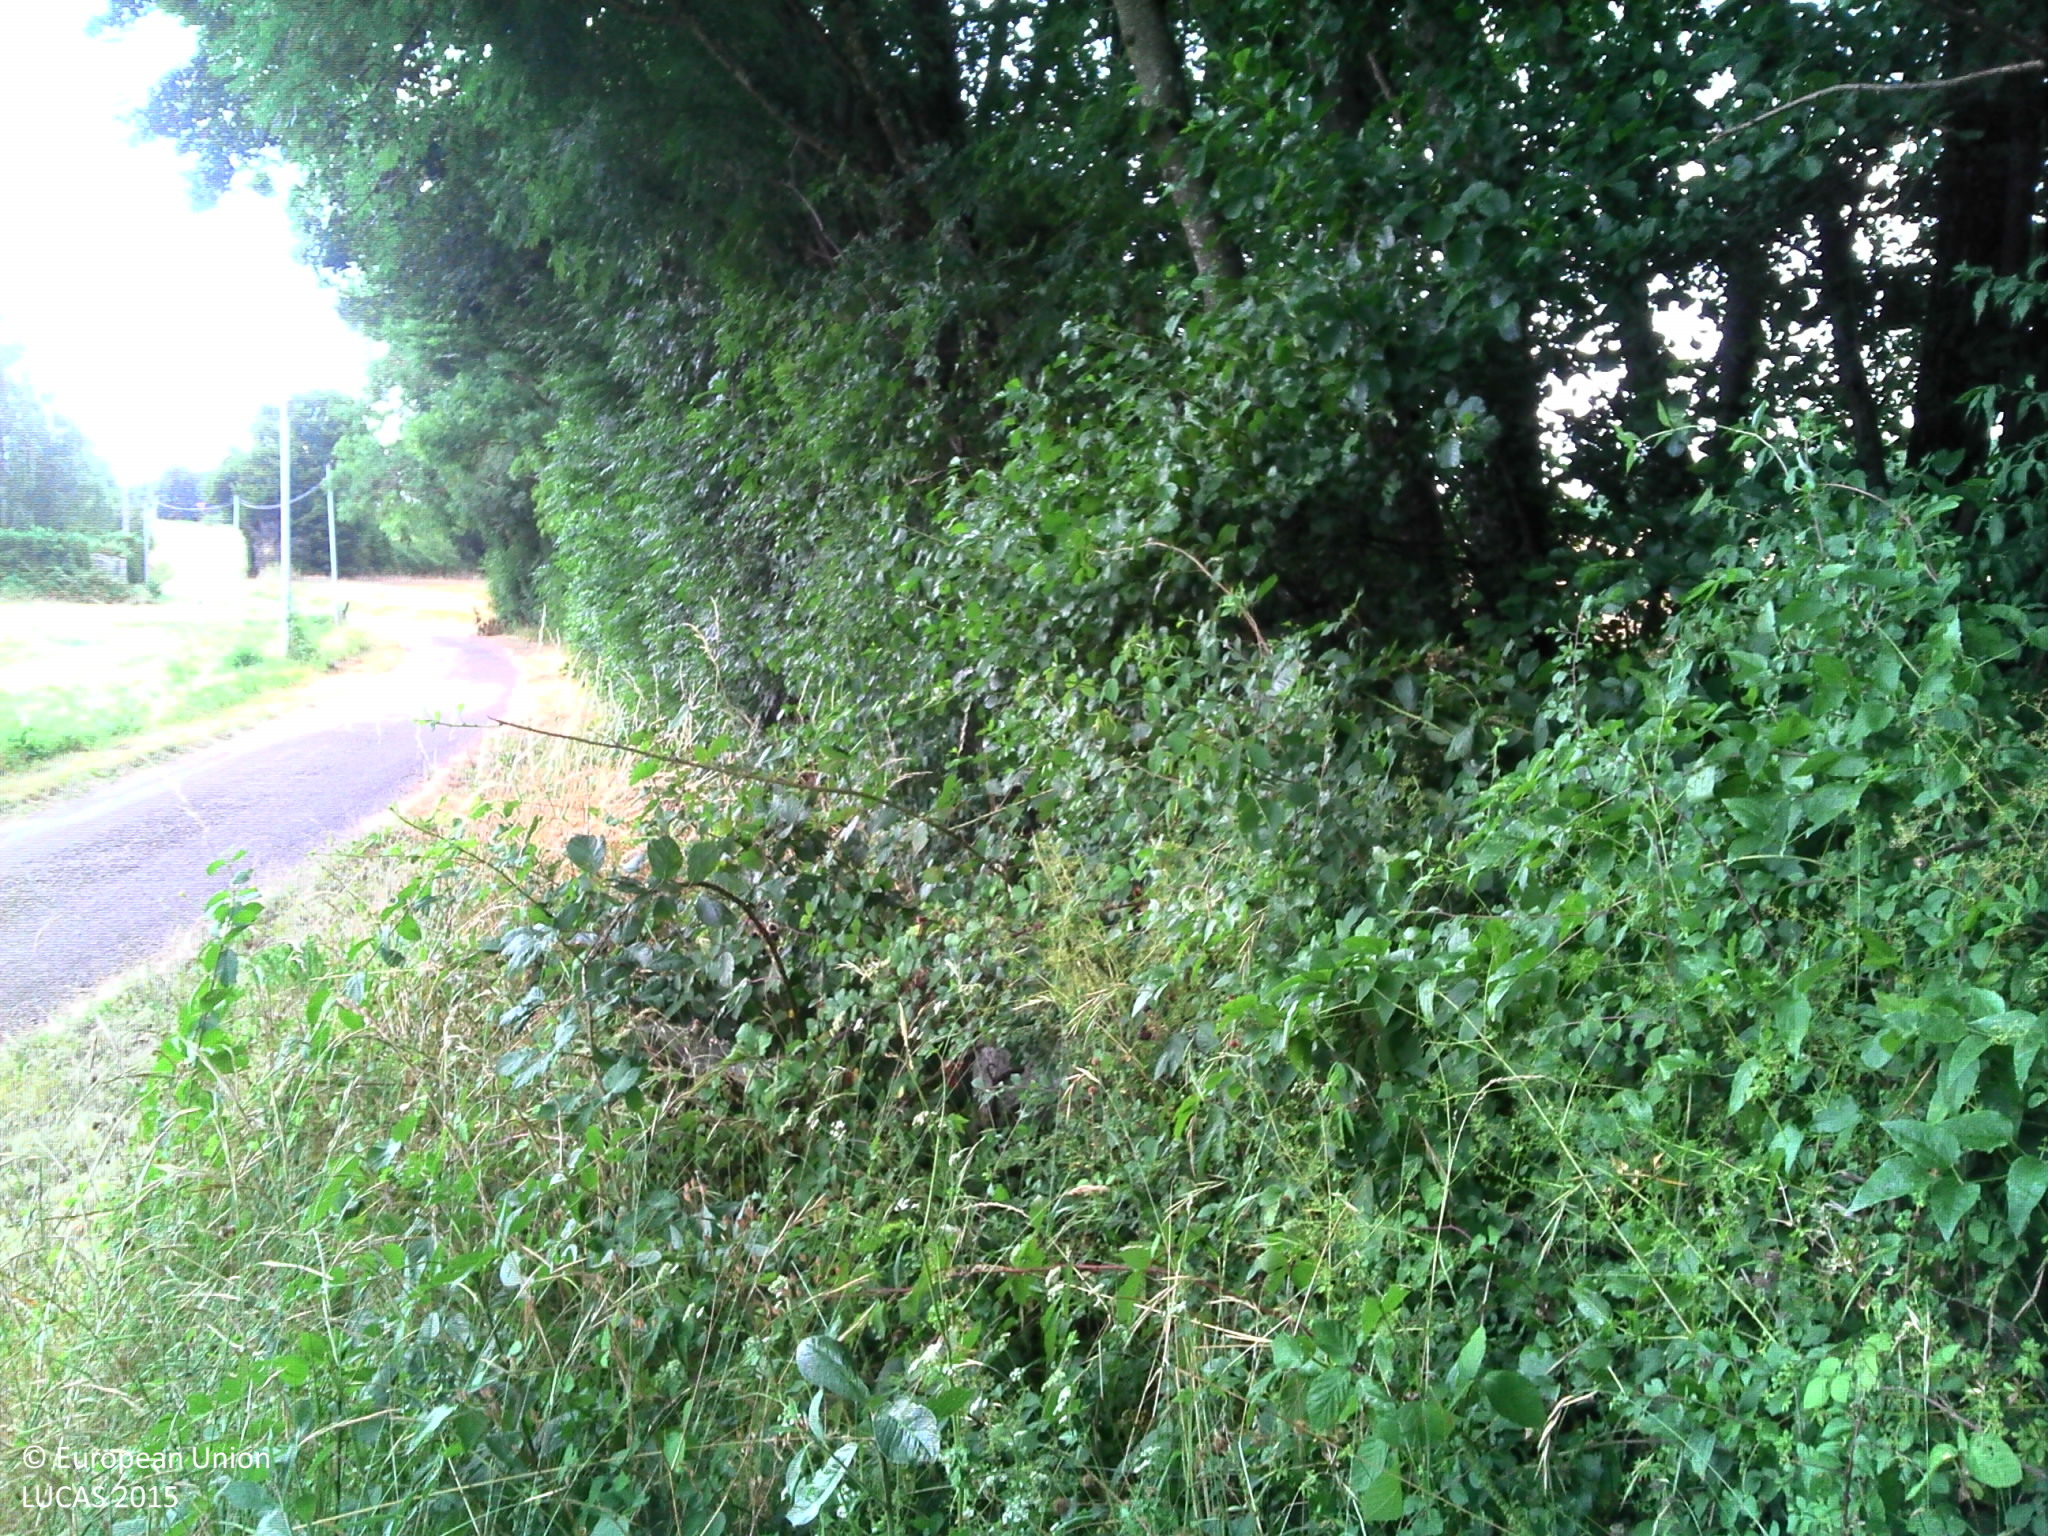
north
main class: Woodland
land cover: Broadleaved woodland
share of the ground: > 75 %
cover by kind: broadleaved forest trees 75 %, herbaceous plants 15 %, shrubs 10 %
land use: Semi-natural and natural areas not in use
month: July
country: FR
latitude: 45.4092
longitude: 5.1110
